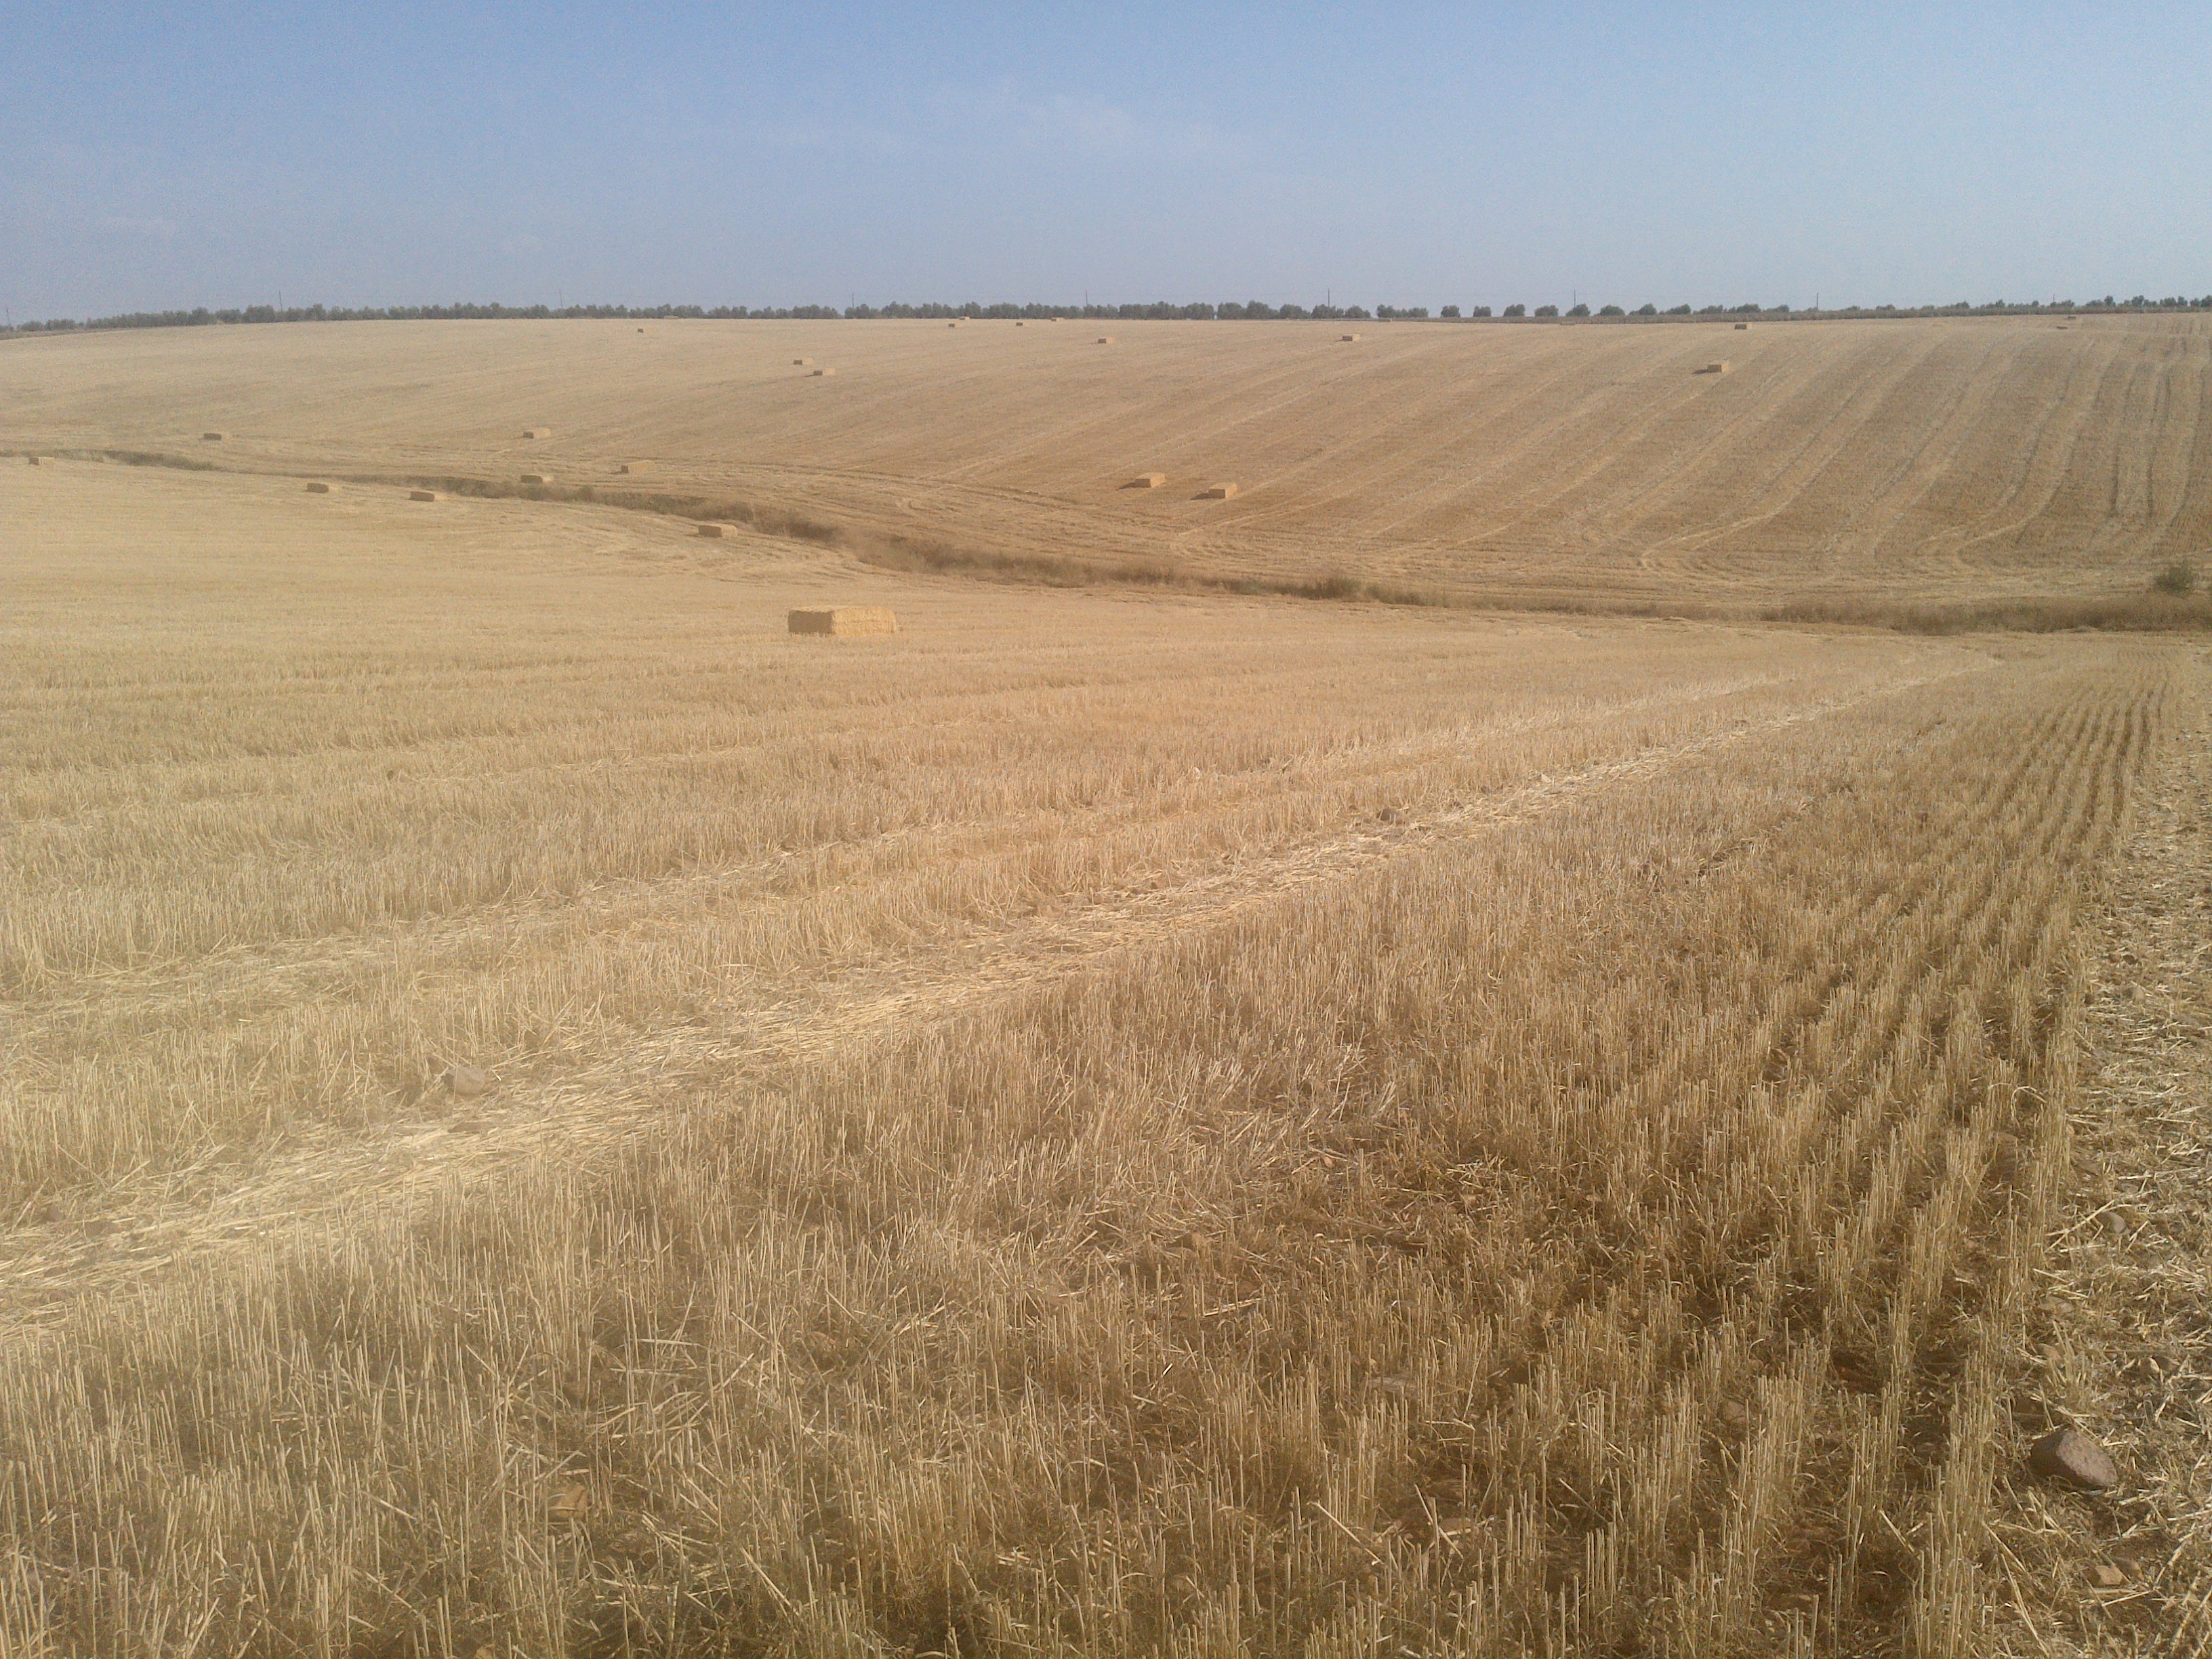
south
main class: Cropland
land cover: Durum wheat
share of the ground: < 10 %
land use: Agriculture (excluding fallow land and kitchen gardens)
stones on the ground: < 10 %
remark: Harvested field
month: June
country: ES
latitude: 37.7454
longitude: -4.8918
